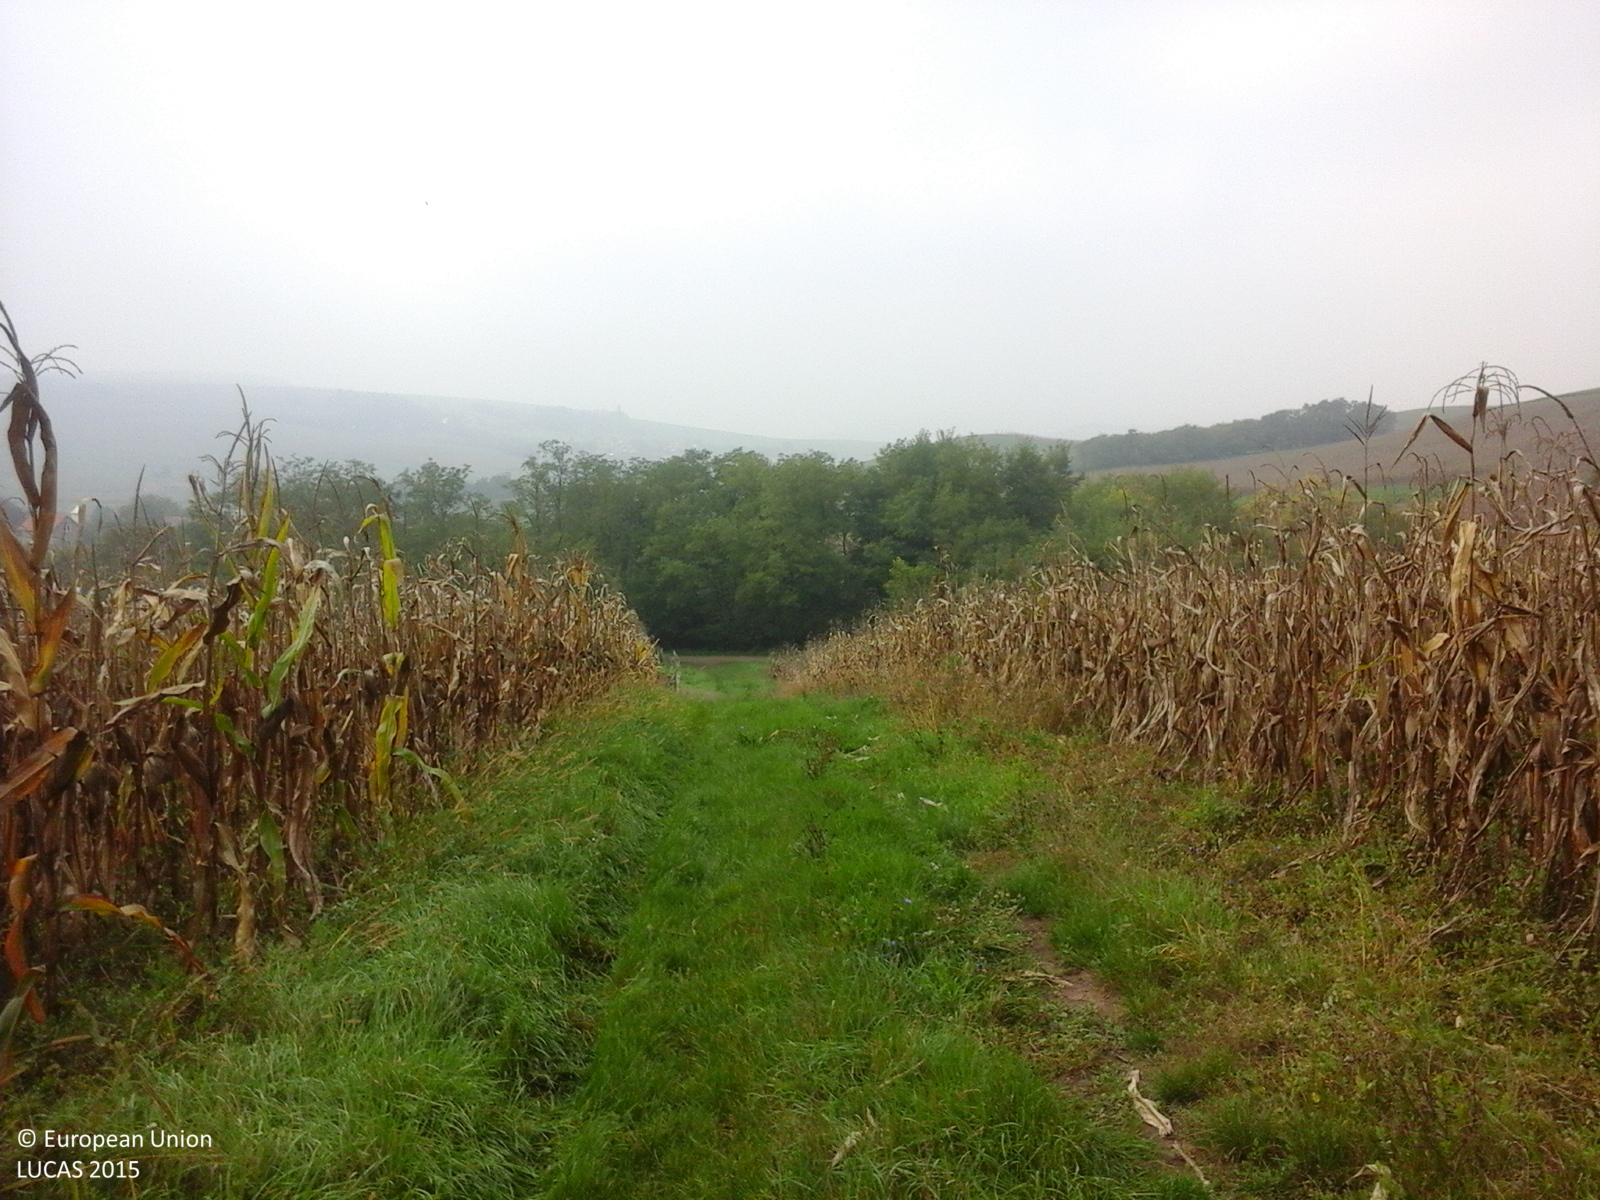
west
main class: Cropland
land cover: Maize
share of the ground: > 75 %
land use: Agriculture (excluding fallow land and kitchen gardens)
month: October
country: RO
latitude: 46.6018
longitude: 24.3532
